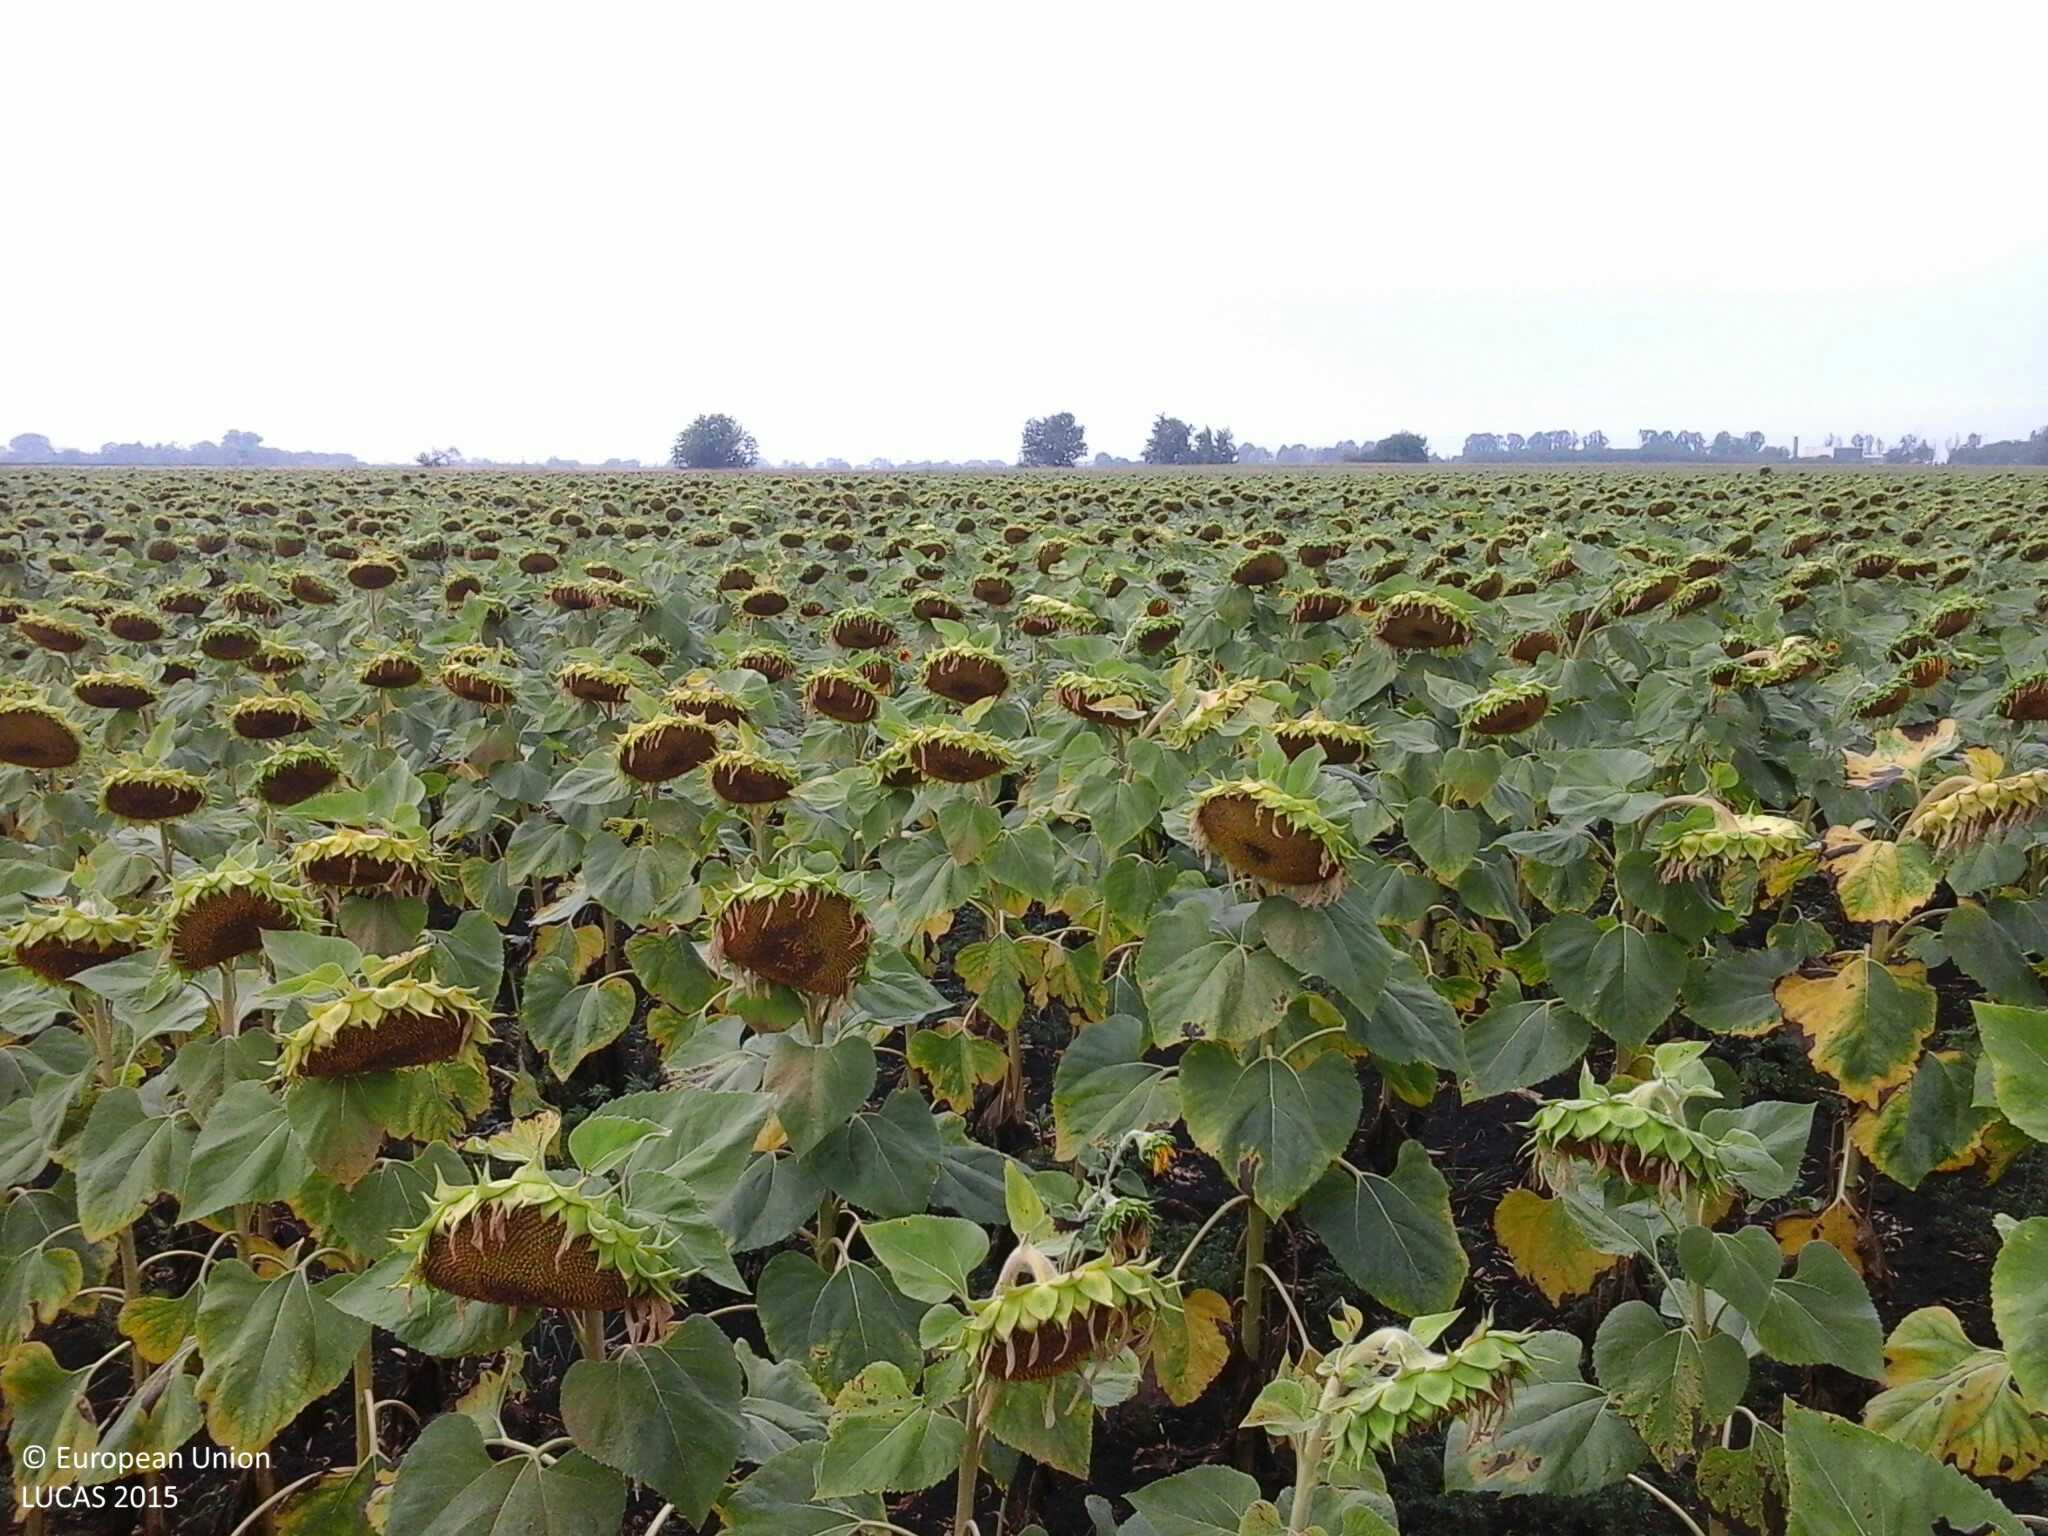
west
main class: Cropland
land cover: Sunflower
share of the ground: > 75 %
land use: Agriculture (excluding fallow land and kitchen gardens)
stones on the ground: < 10 %
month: August
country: HU
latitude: 47.9229
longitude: 21.0260
